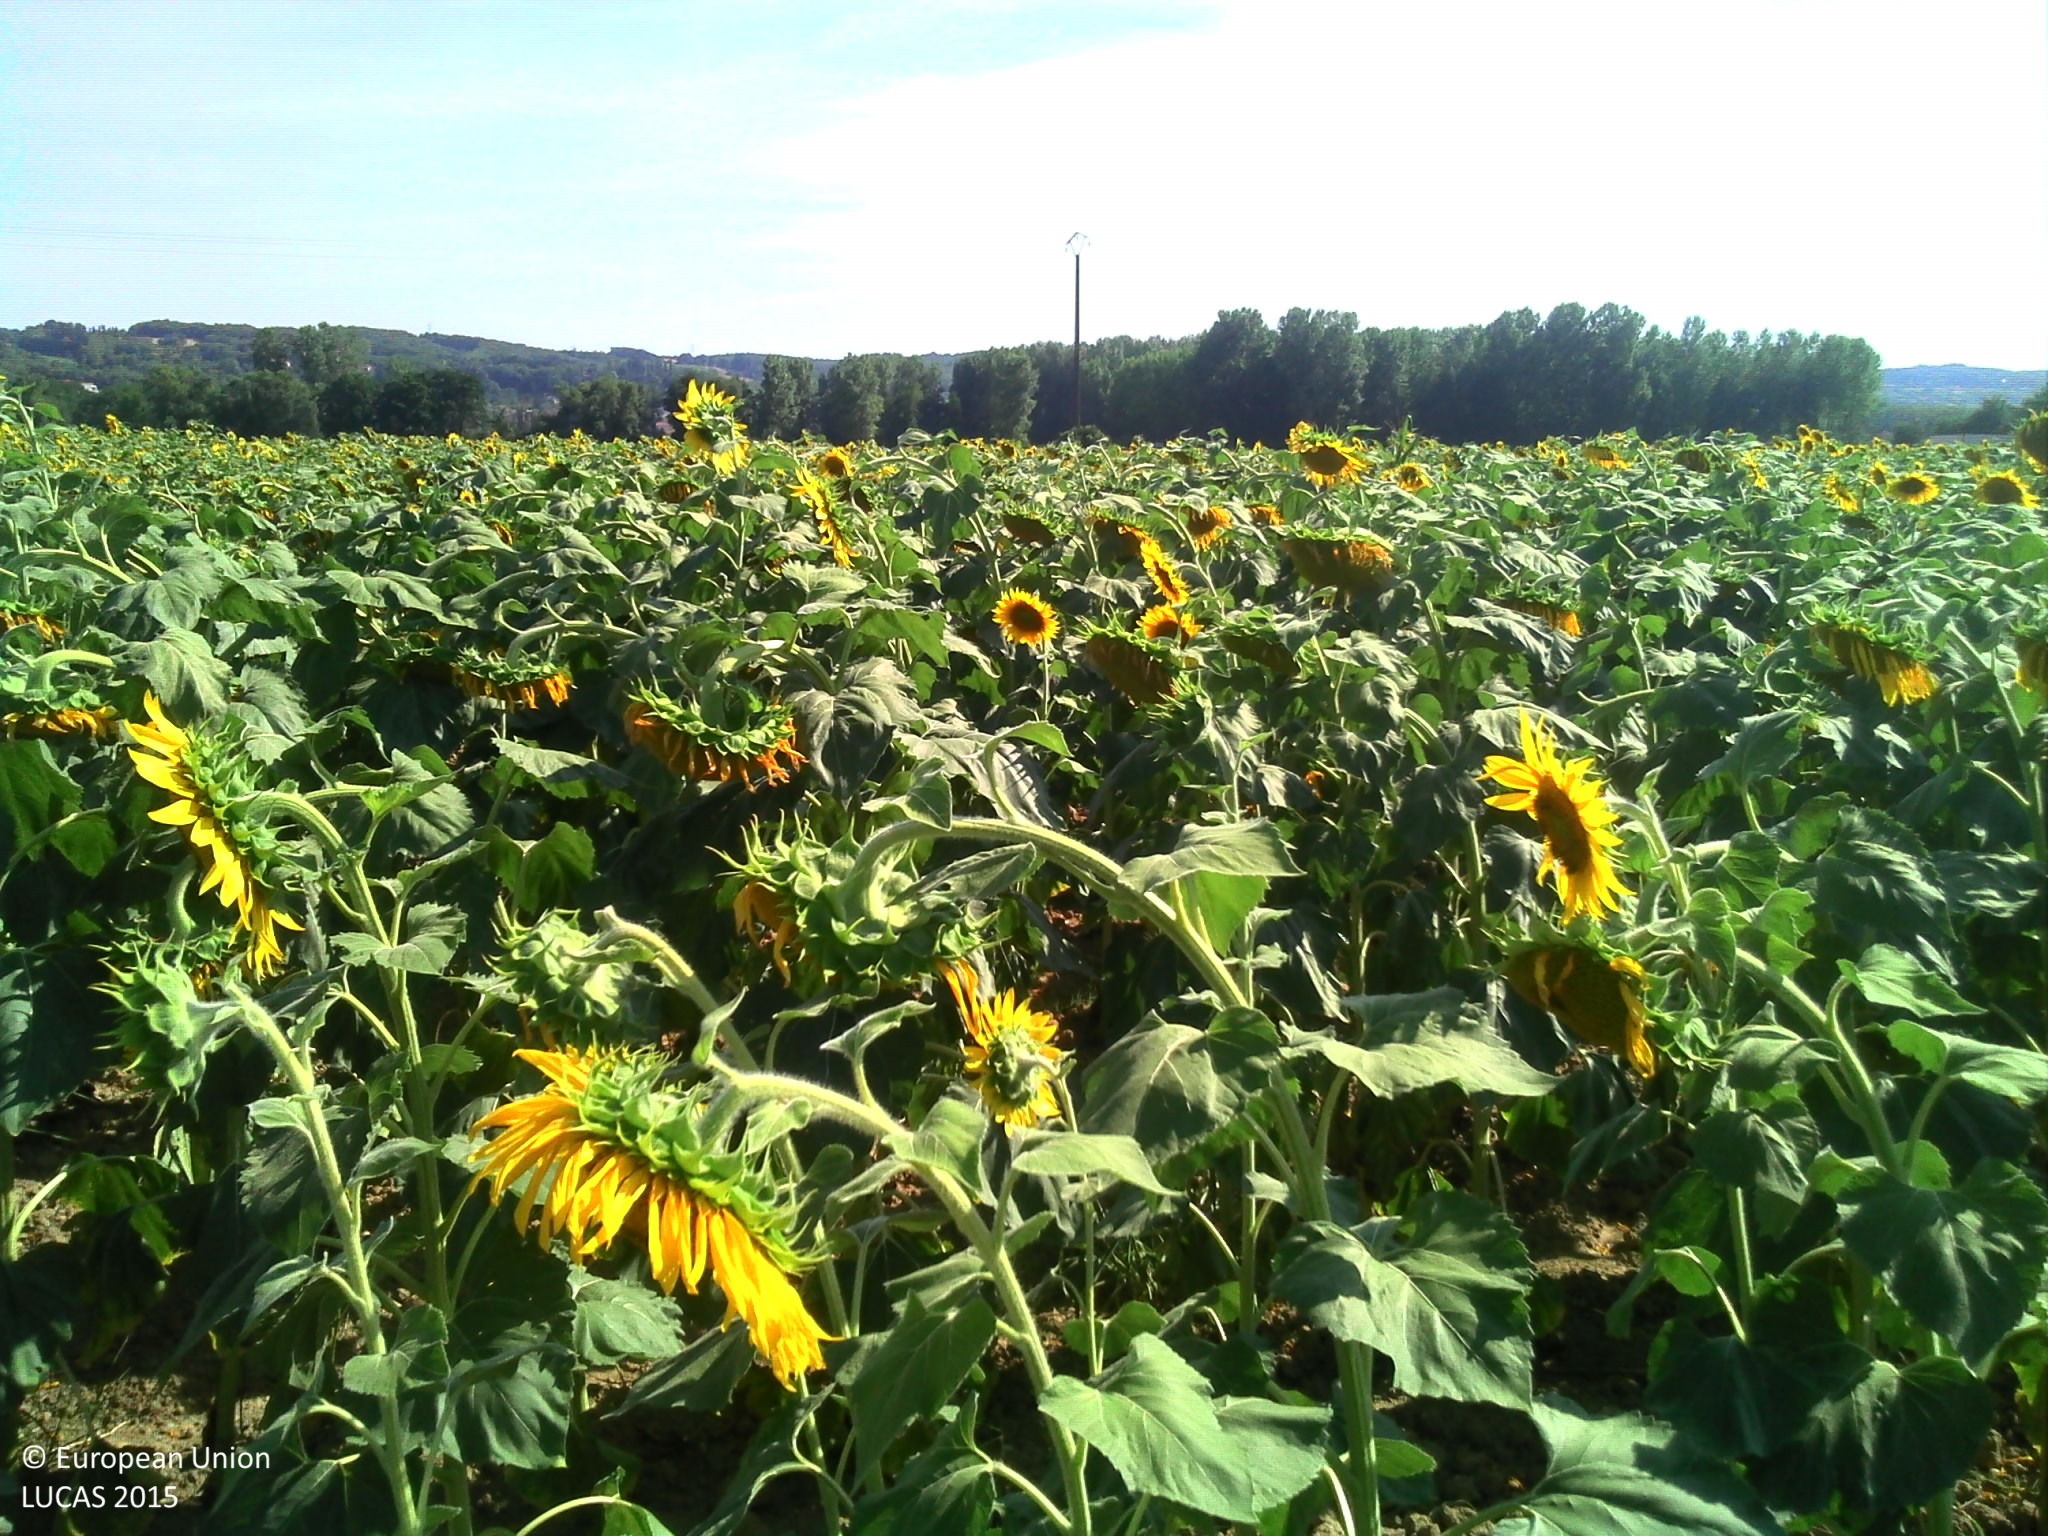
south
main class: Cropland
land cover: Sunflower
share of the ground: > 75 %
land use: Agriculture (excluding fallow land and kitchen gardens)
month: August
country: FR
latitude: 45.6345
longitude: 4.9111
